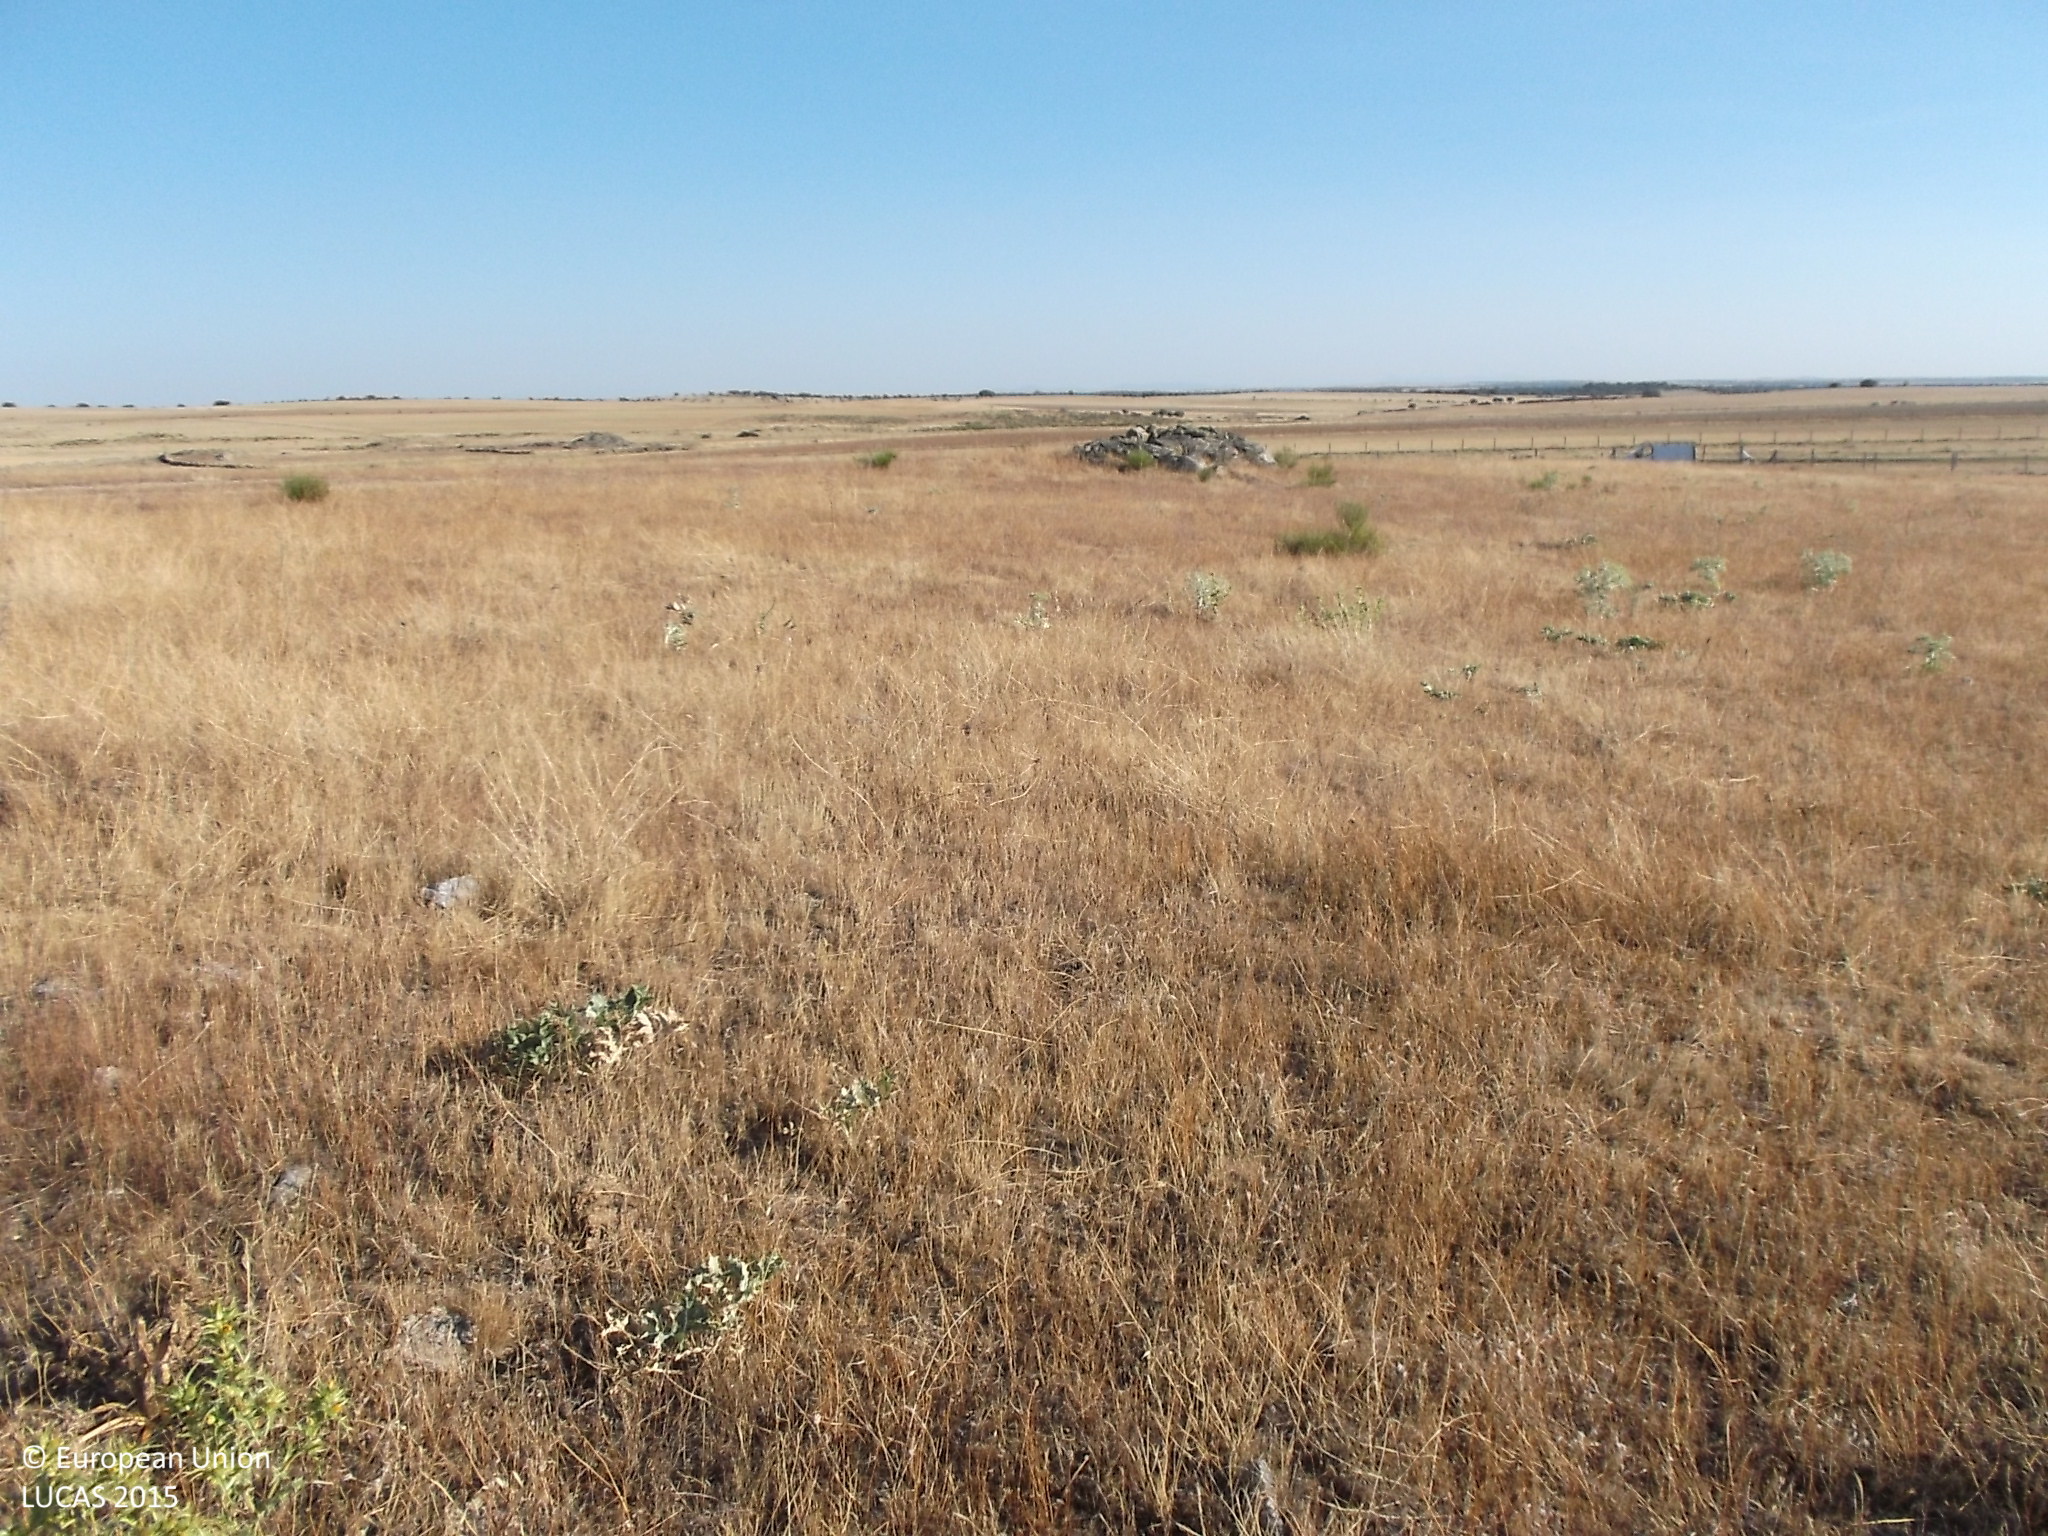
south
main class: Grassland
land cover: Grassland without tree/shrub cover
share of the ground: > 75 %
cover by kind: herbaceous plants 100 %
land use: Agriculture (excluding fallow land and kitchen gardens)
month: July
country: ES
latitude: 41.1428
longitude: -5.9433
